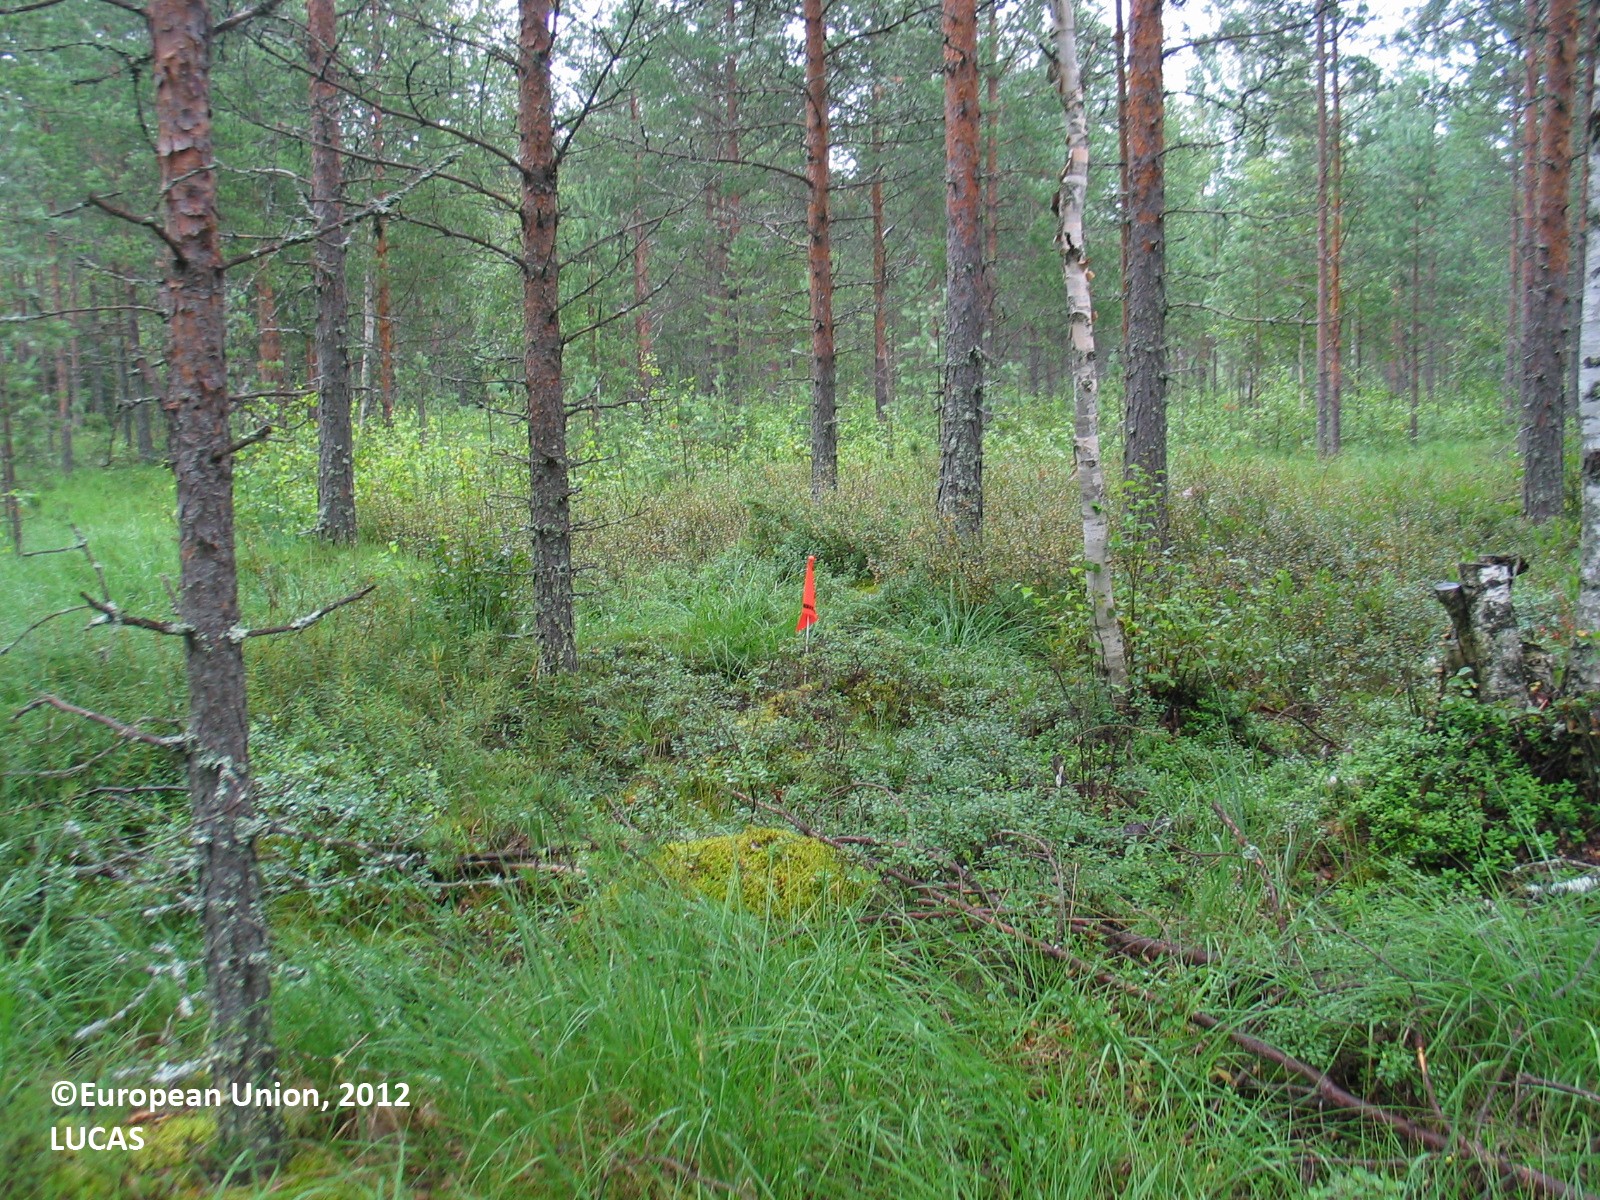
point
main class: Woodland
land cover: Pine dominated mixed woodland
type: mire and swamp forests
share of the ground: 25 - 50 %
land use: Forestry
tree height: > 5 m
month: August
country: FI
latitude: 64.5969
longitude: 25.9997
